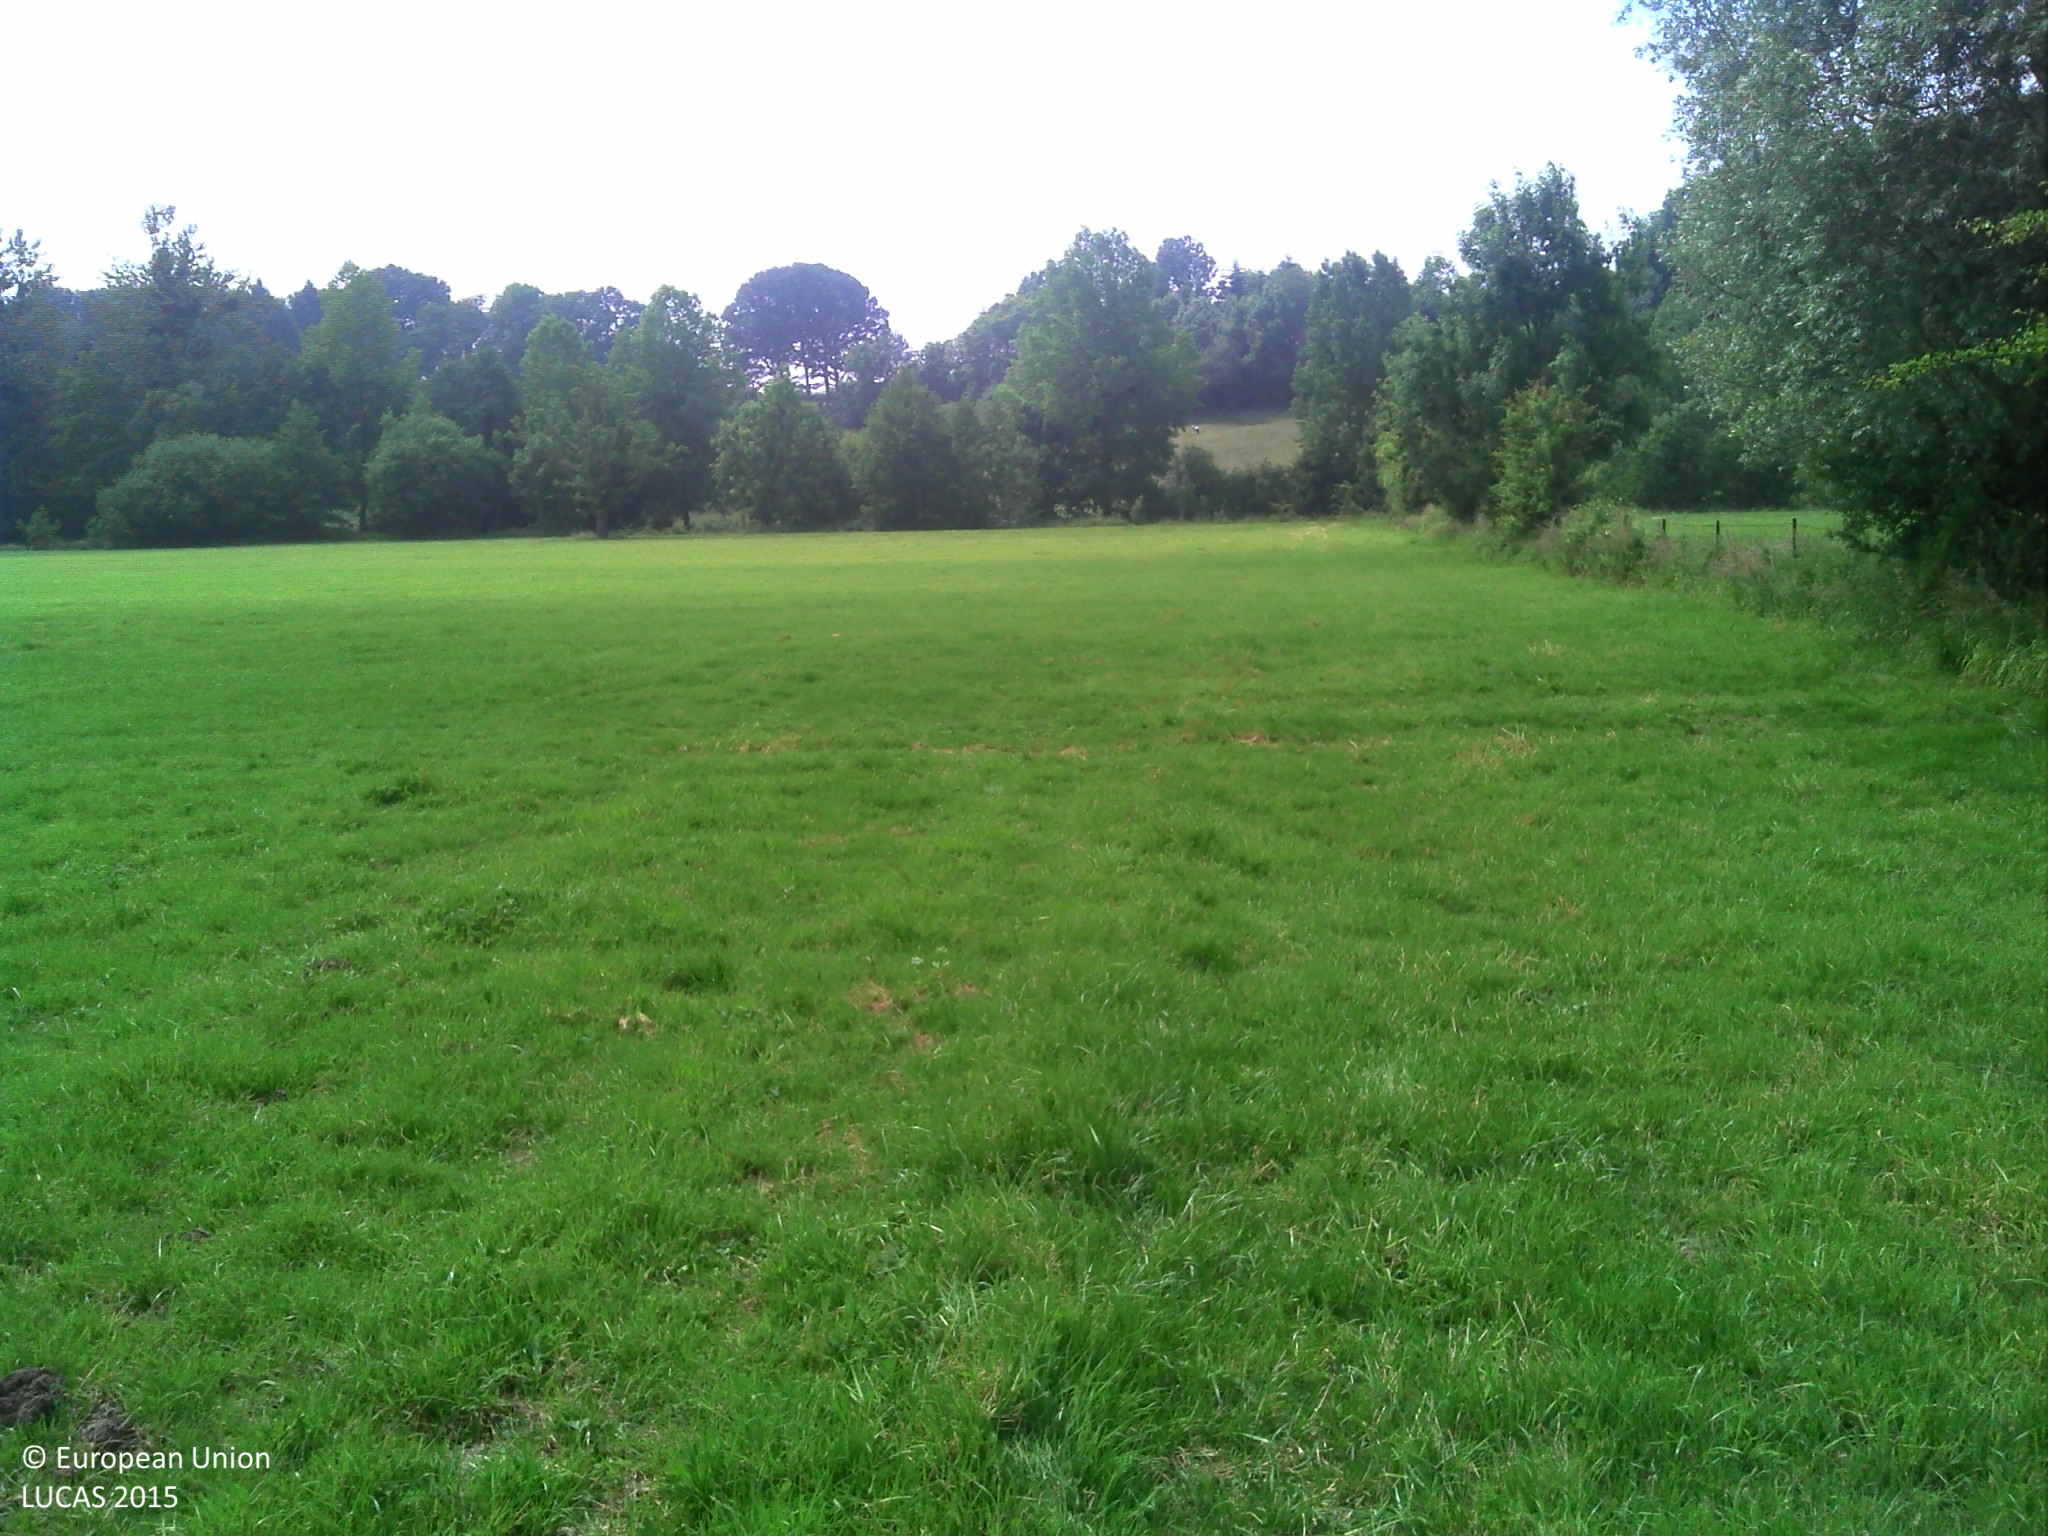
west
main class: Grassland
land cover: Grassland without tree/shrub cover
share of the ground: > 75 %
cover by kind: herbaceous plants 100 %
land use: Agriculture (excluding fallow land and kitchen gardens)
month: June
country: FR
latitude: 49.9370
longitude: 4.0173
